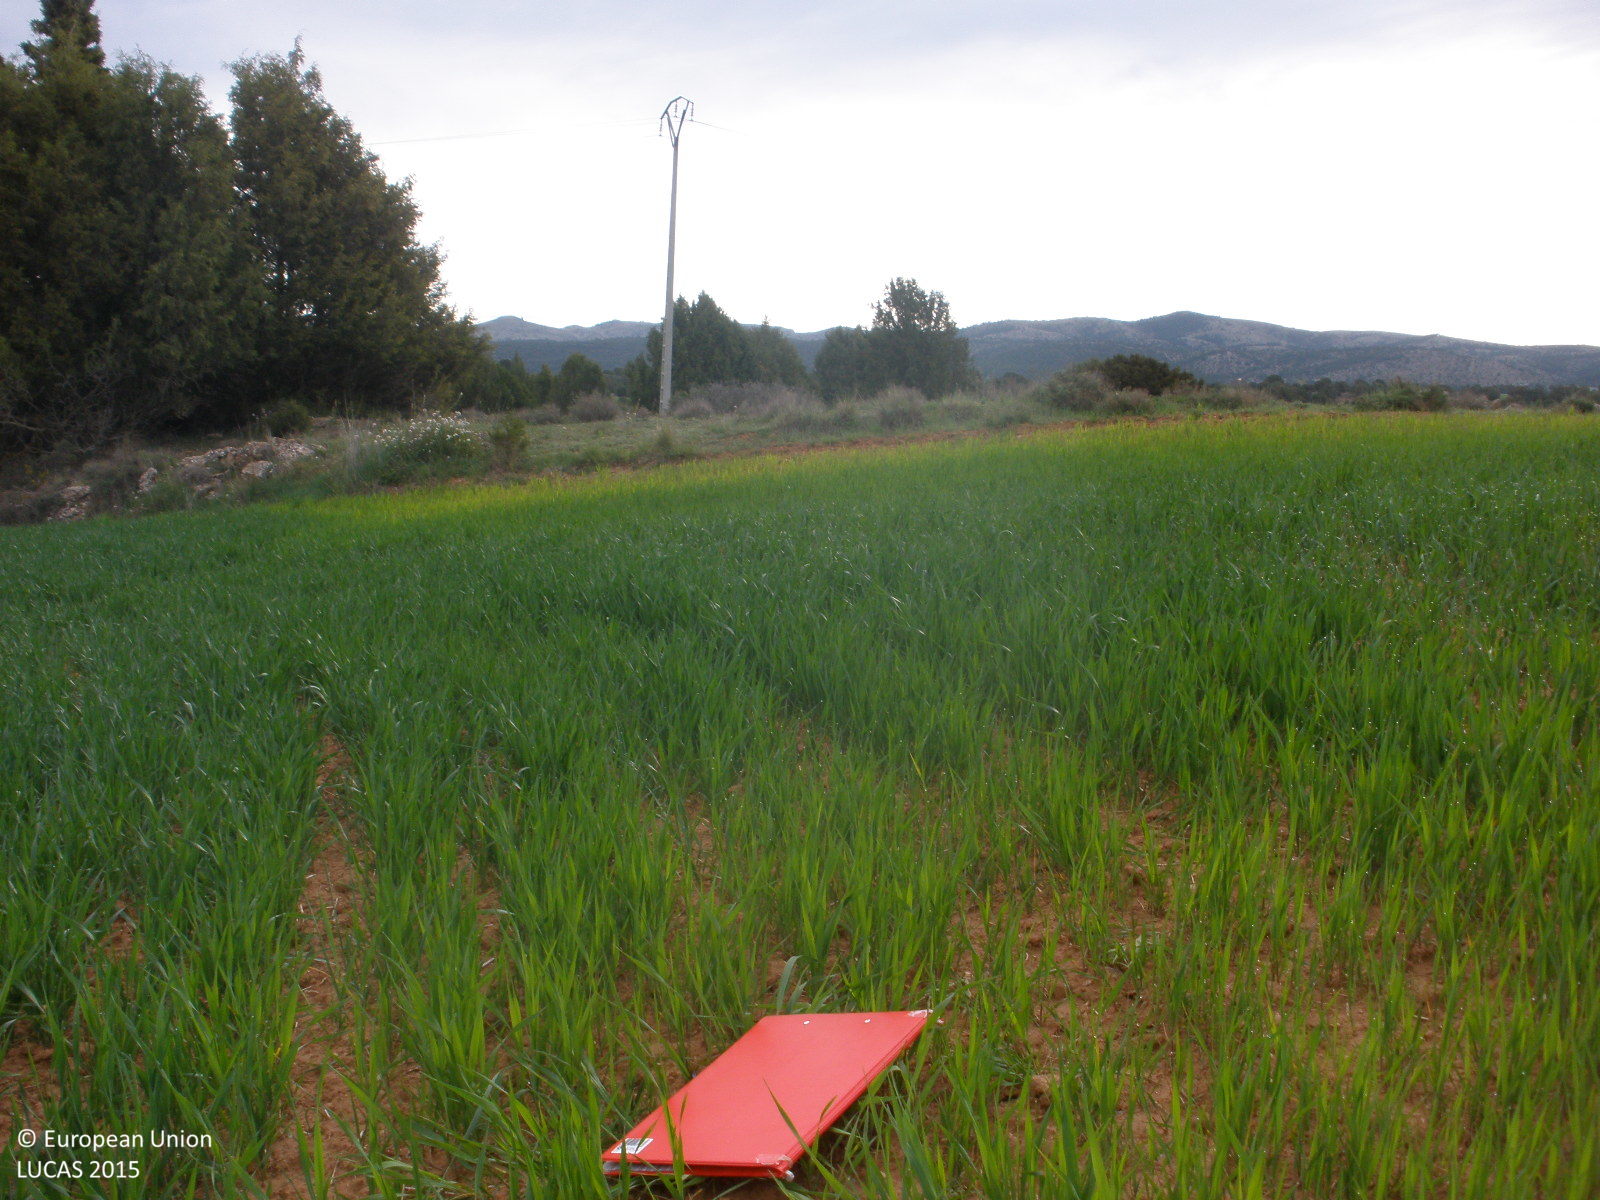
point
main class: Cropland
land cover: Barley
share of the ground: > 75 %
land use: Agriculture (excluding fallow land and kitchen gardens)
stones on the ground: < 10 %
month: May
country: ES
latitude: 40.4124
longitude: -1.0055
